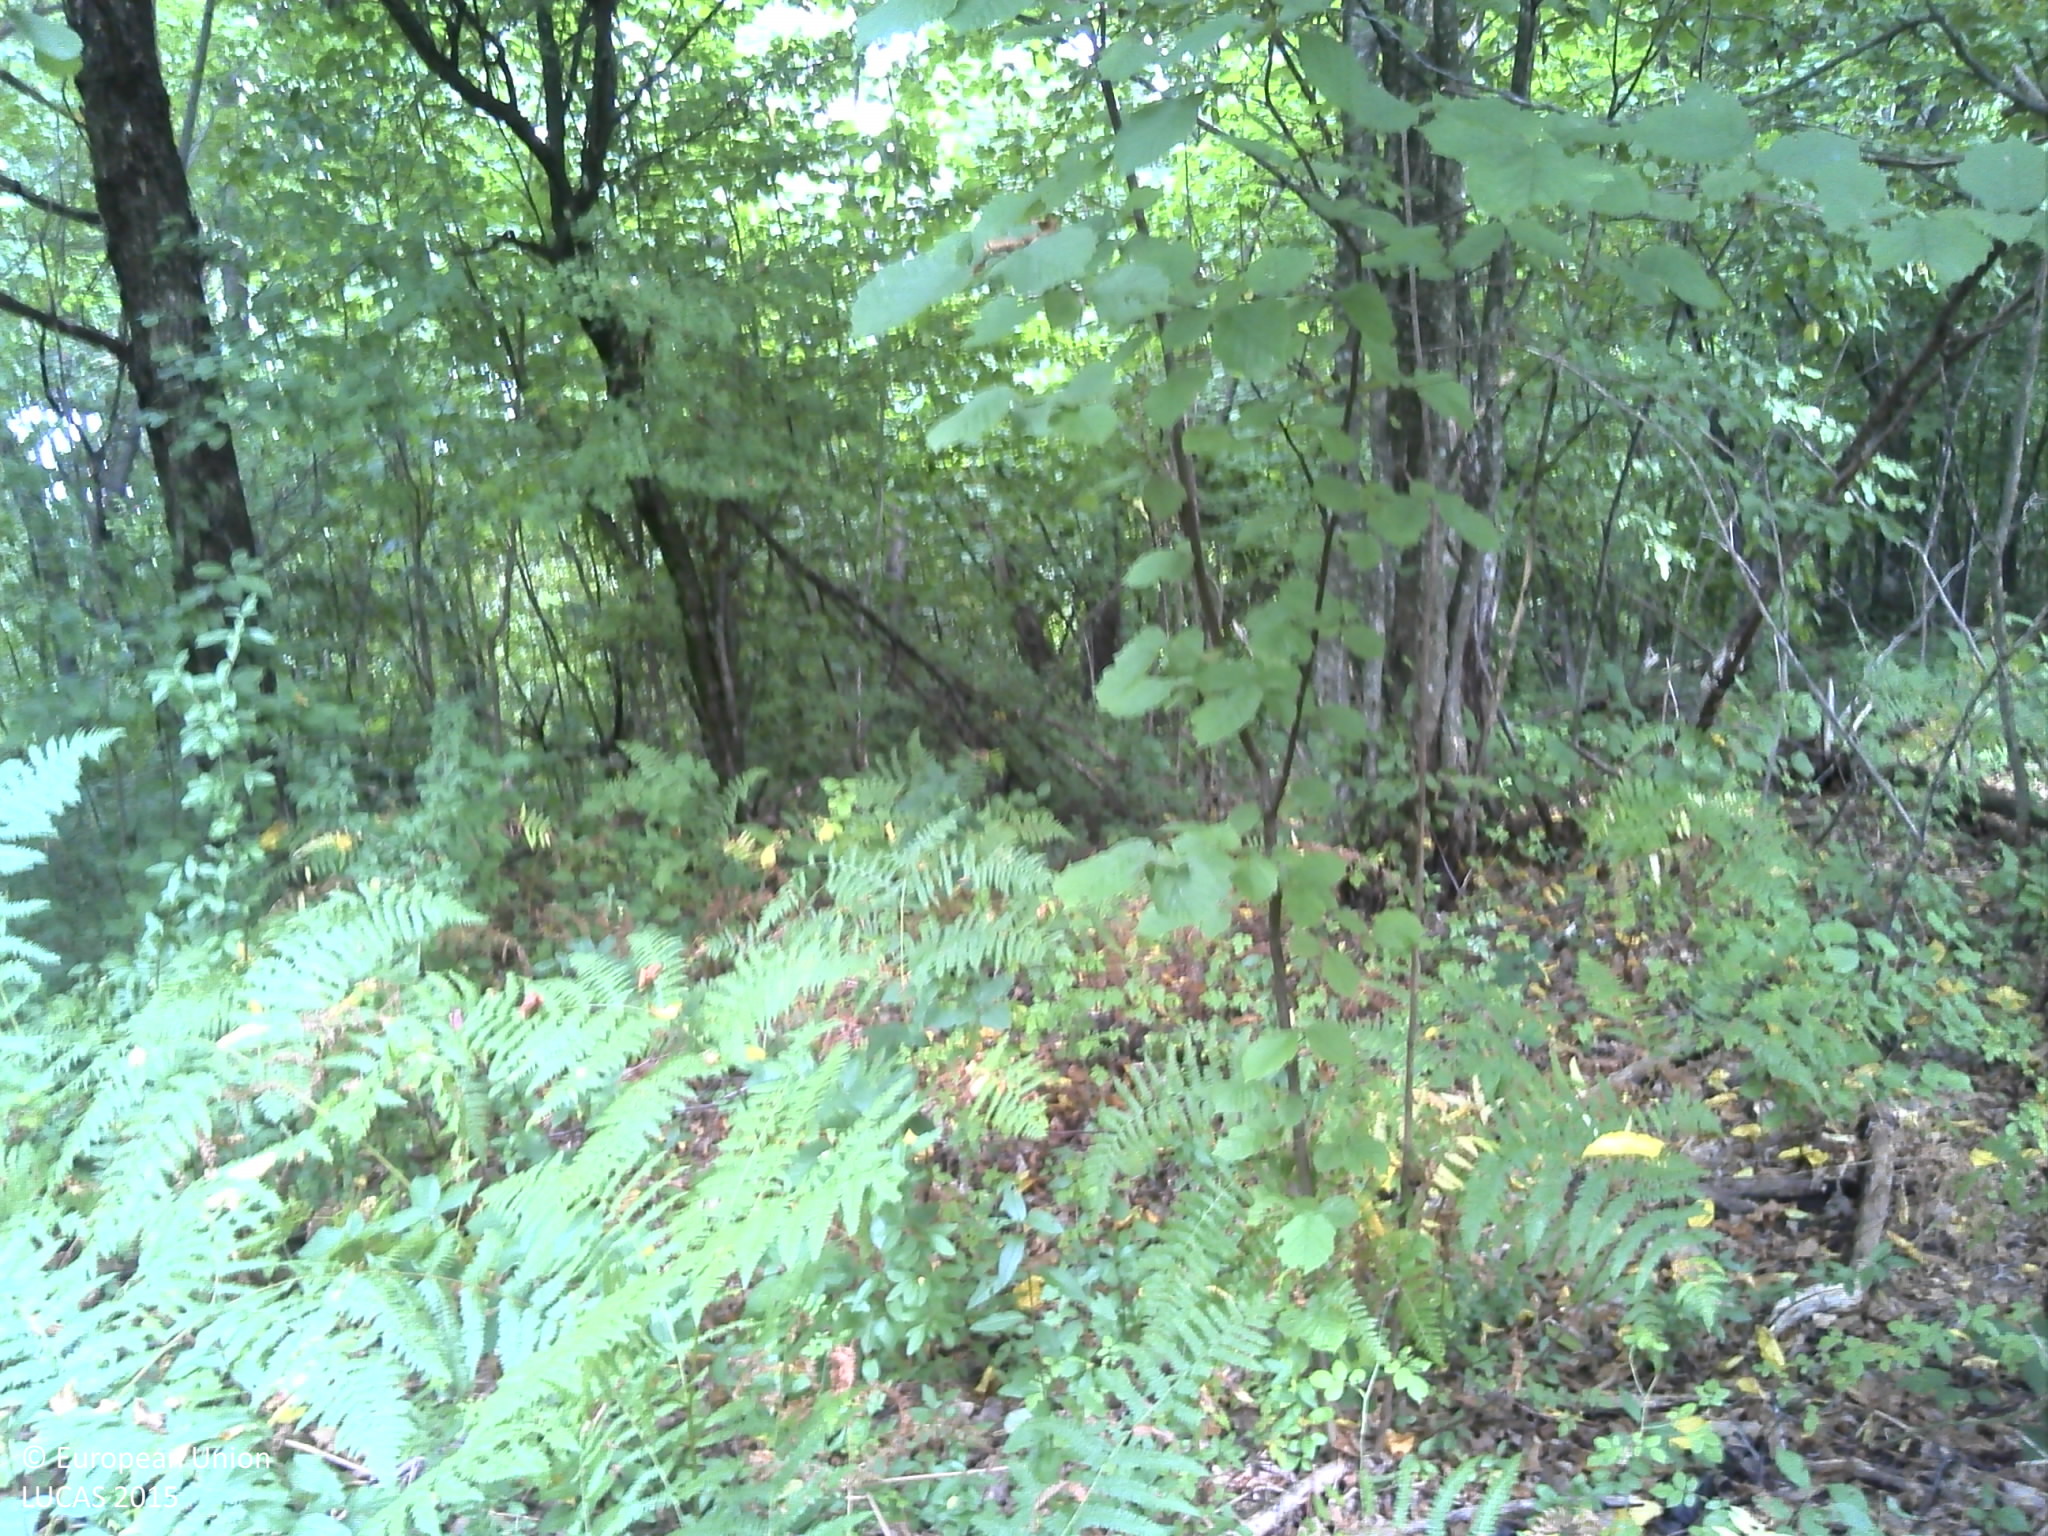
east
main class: Woodland
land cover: Broadleaved woodland
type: beech forest
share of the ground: > 75 %
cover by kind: broadleaved forest trees 100 %
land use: Forestry
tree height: > 5 m
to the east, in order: Broadleaved woodland; Spontaneously vegetated surfaces; Broadleaved woodland
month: August
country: HR
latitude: 45.2722
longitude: 16.1276
